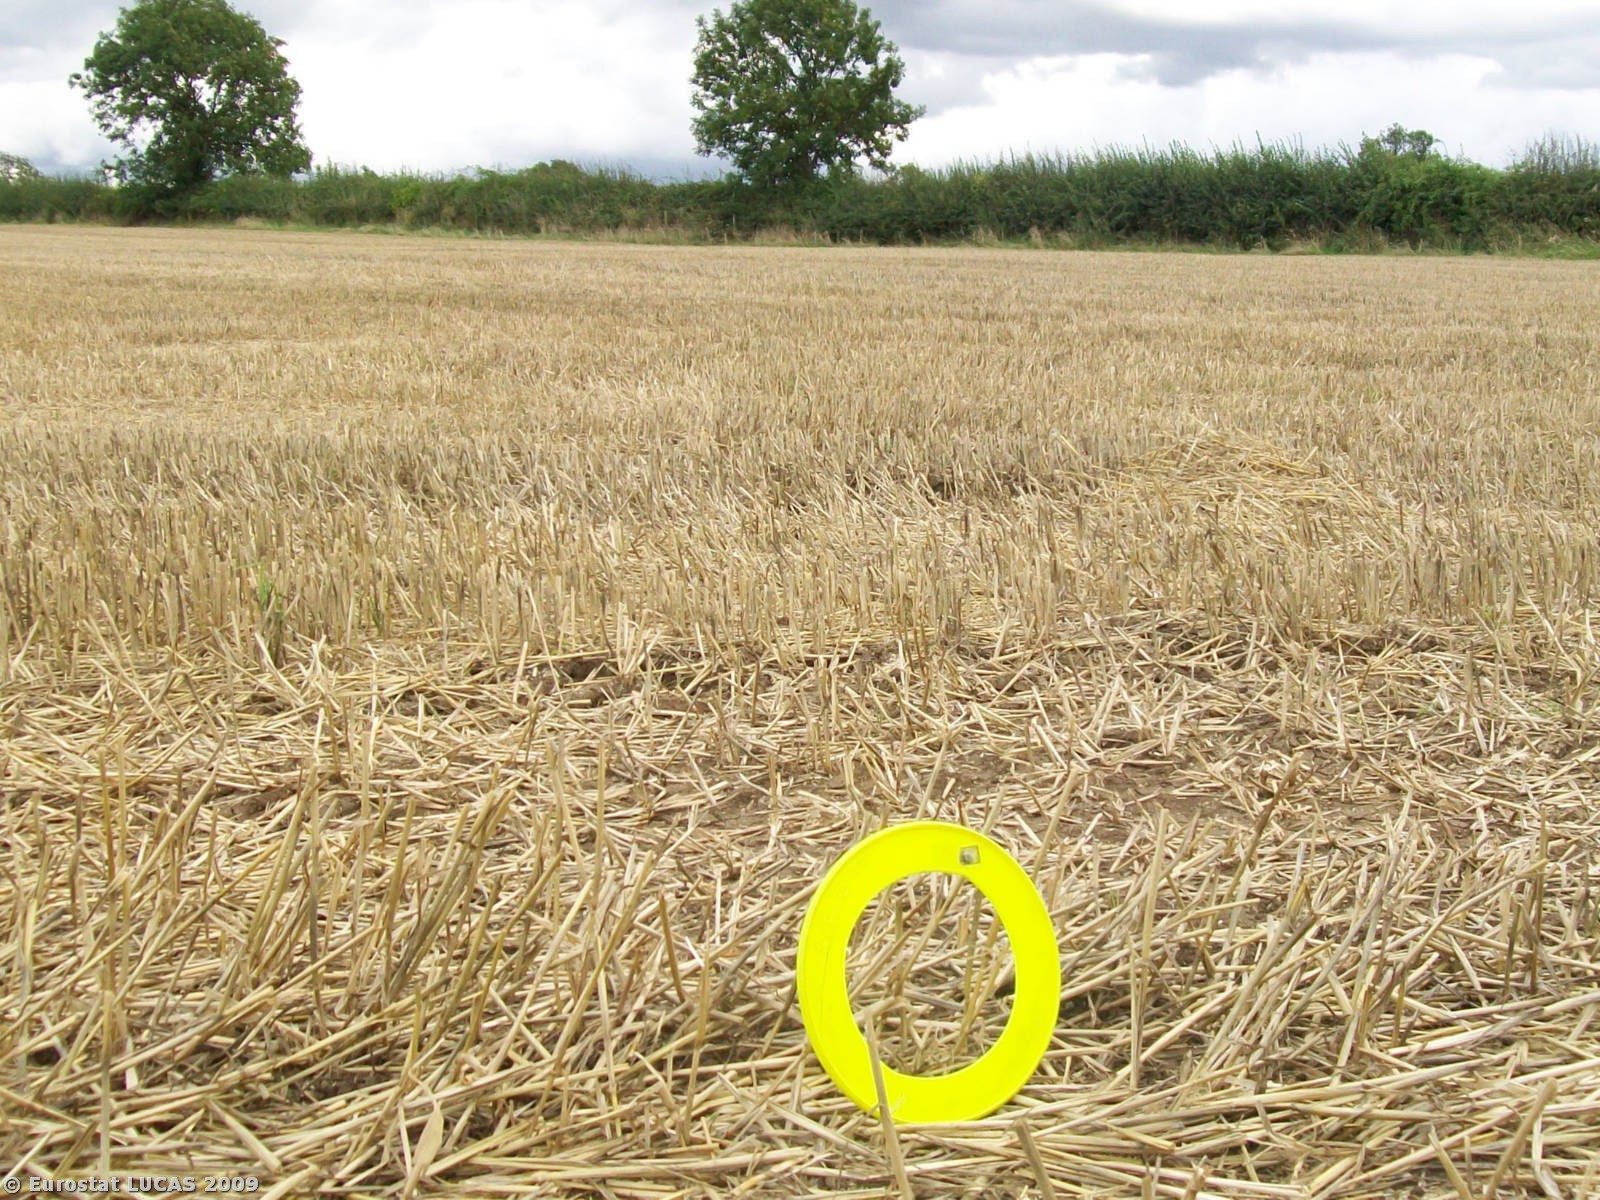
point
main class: Cropland
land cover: Common wheat
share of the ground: < 10 %
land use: Agriculture (excluding fallow land and kitchen gardens)
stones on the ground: < 10 %
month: August
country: GB
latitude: 52.5077
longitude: -1.1104
